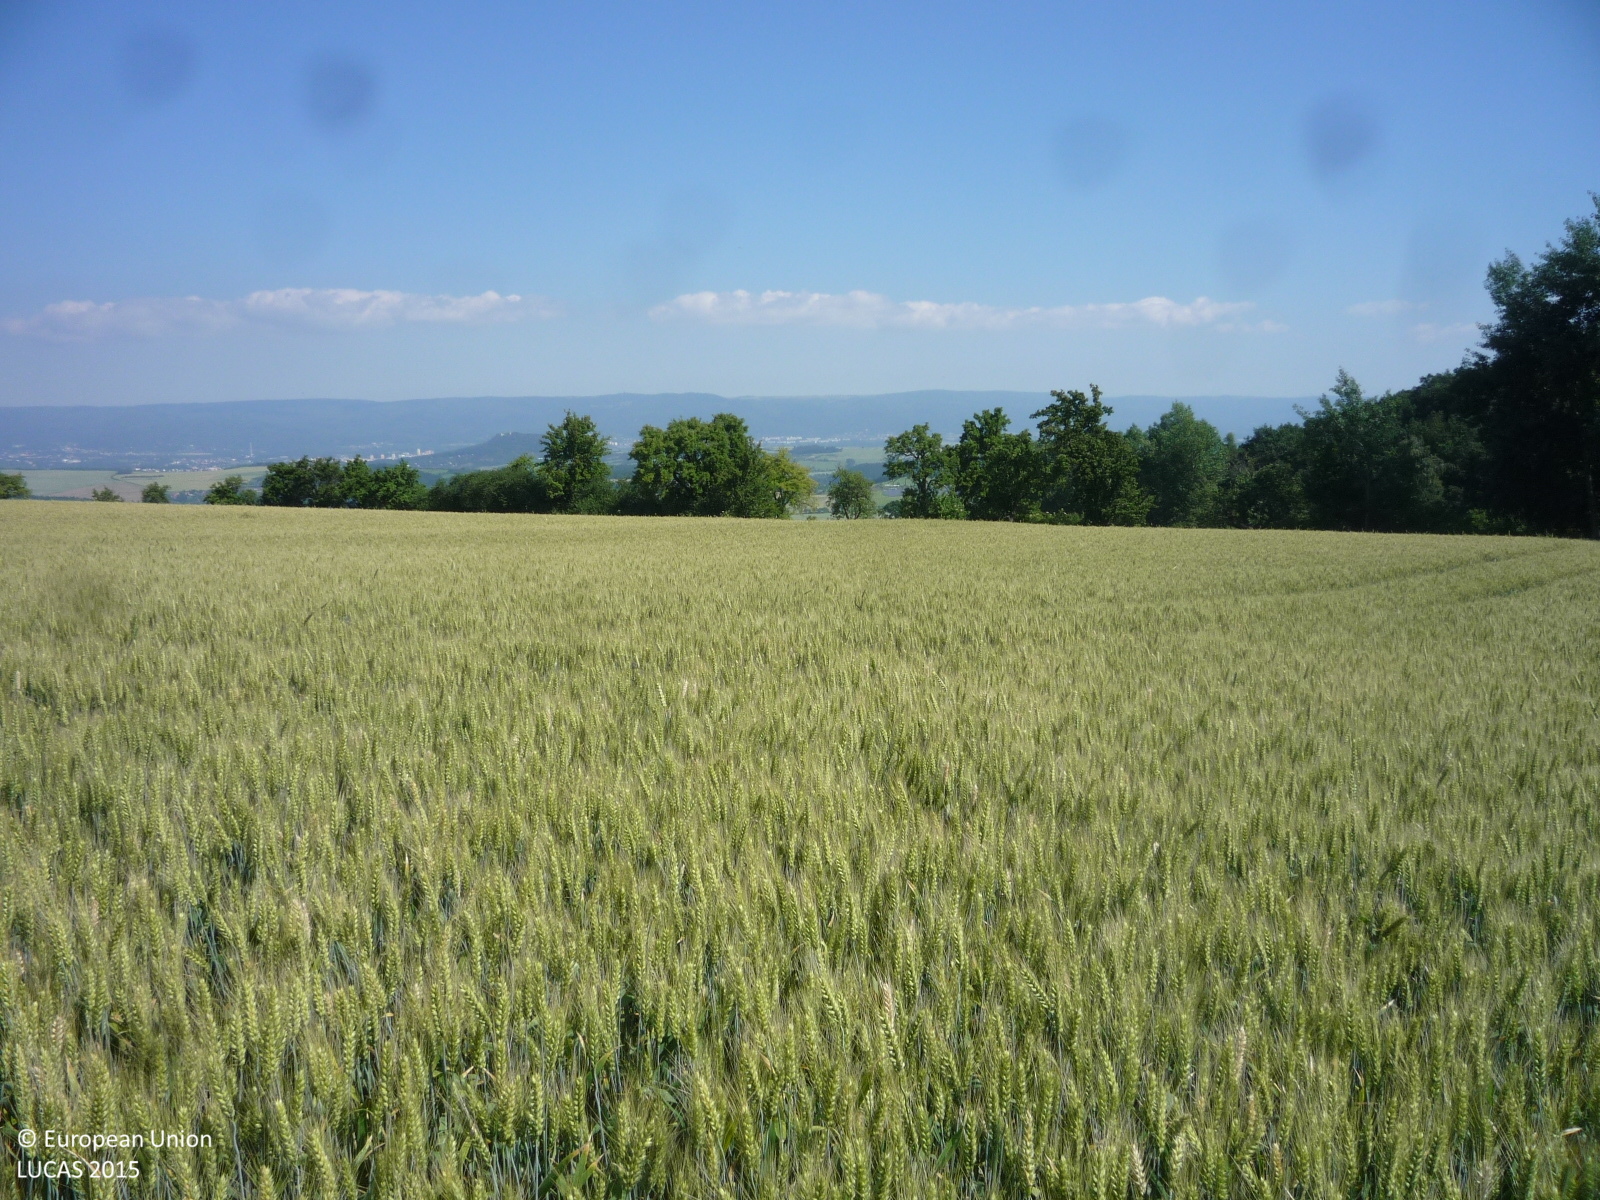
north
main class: Cropland
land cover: Common wheat
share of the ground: > 75 %
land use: Agriculture (excluding fallow land and kitchen gardens)
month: July
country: CZ
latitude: 50.5682
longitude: 13.8835
